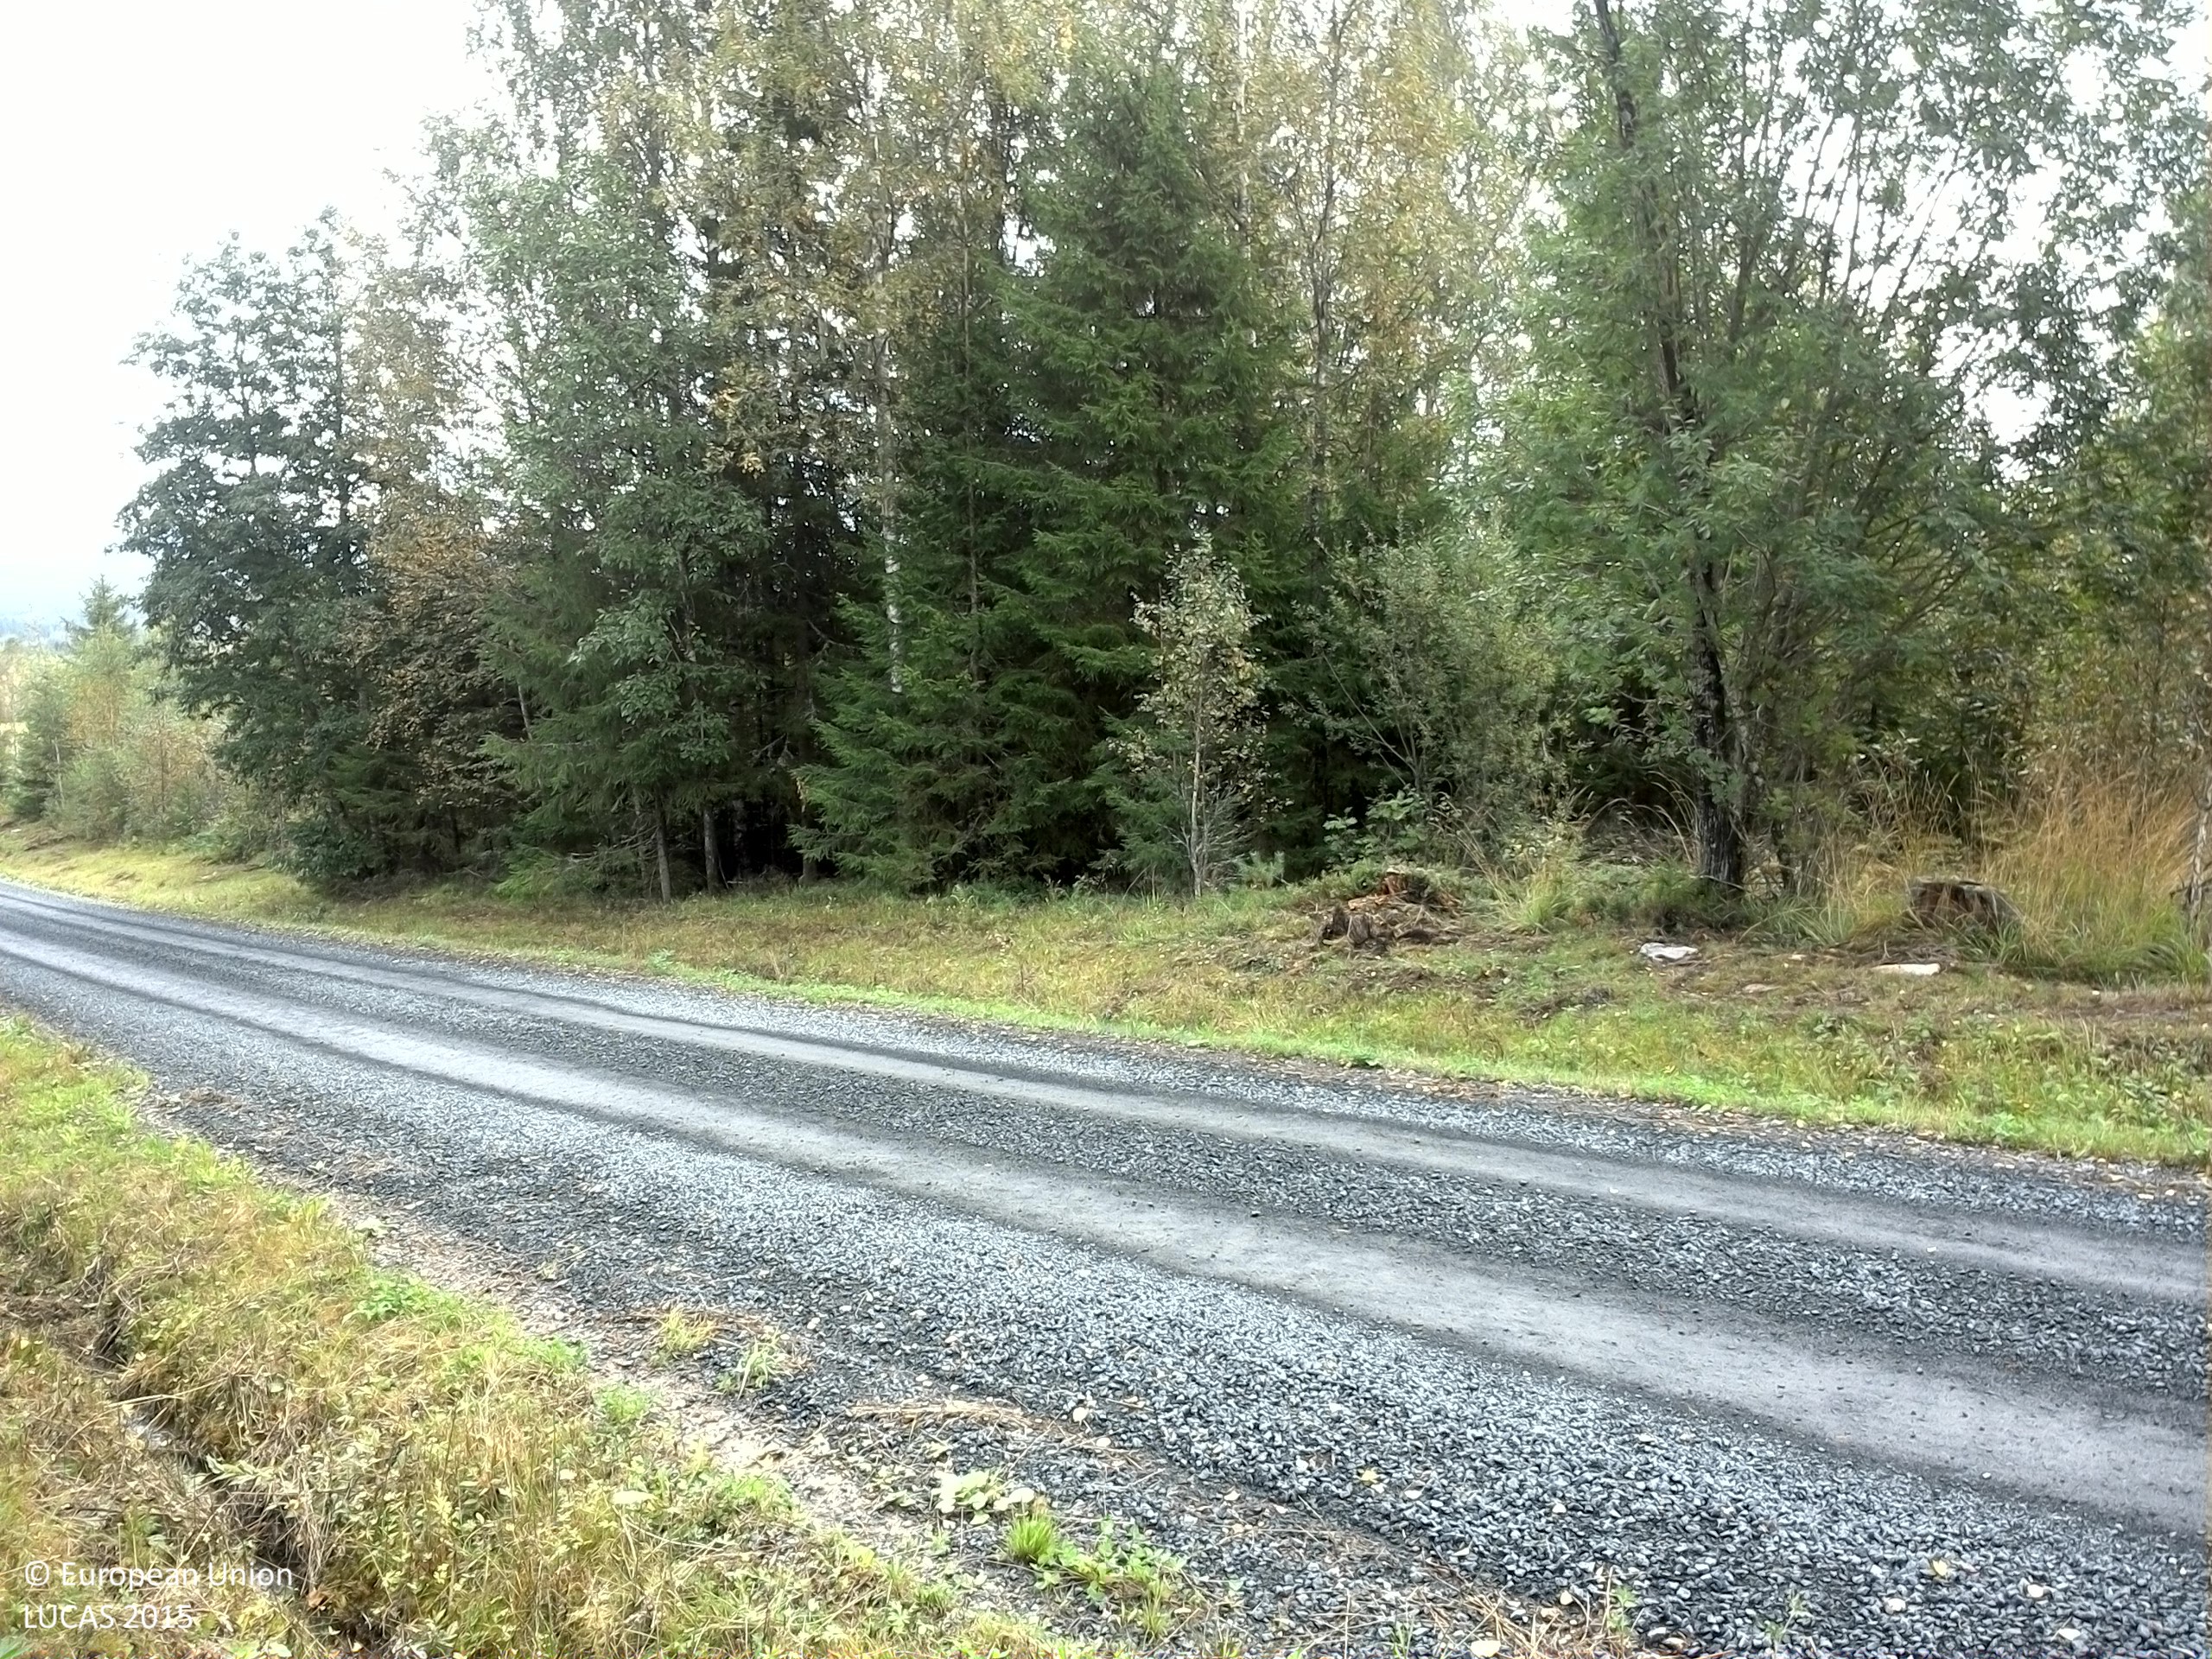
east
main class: Woodland
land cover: Spruce dominated mixed woodland
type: boreal forest
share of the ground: 25 - 50 %
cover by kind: coniferous forest trees 25 %, broadleaved forest trees 25 %, shrubs 20 %, herbaceous plants 15 %, lichens and mosses 15 %
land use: Forestry
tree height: > 5 m
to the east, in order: Grass margins; Ditches and canals; Grass margins; Paved roads, cycling and walking lanes; Grass margins; Ditches and canals; Grass margins; Spruce dominated mixed woodland; Shrubland with sparse tree cover; Rivers and streams; Shrubland with sparse tree cover; Broadleaved woodland; Grassland without tree/shrub cover; Artificial constructions in urban areas; Grassland without tree/shrub cover
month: September
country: SE
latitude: 59.9642
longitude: 13.1975
